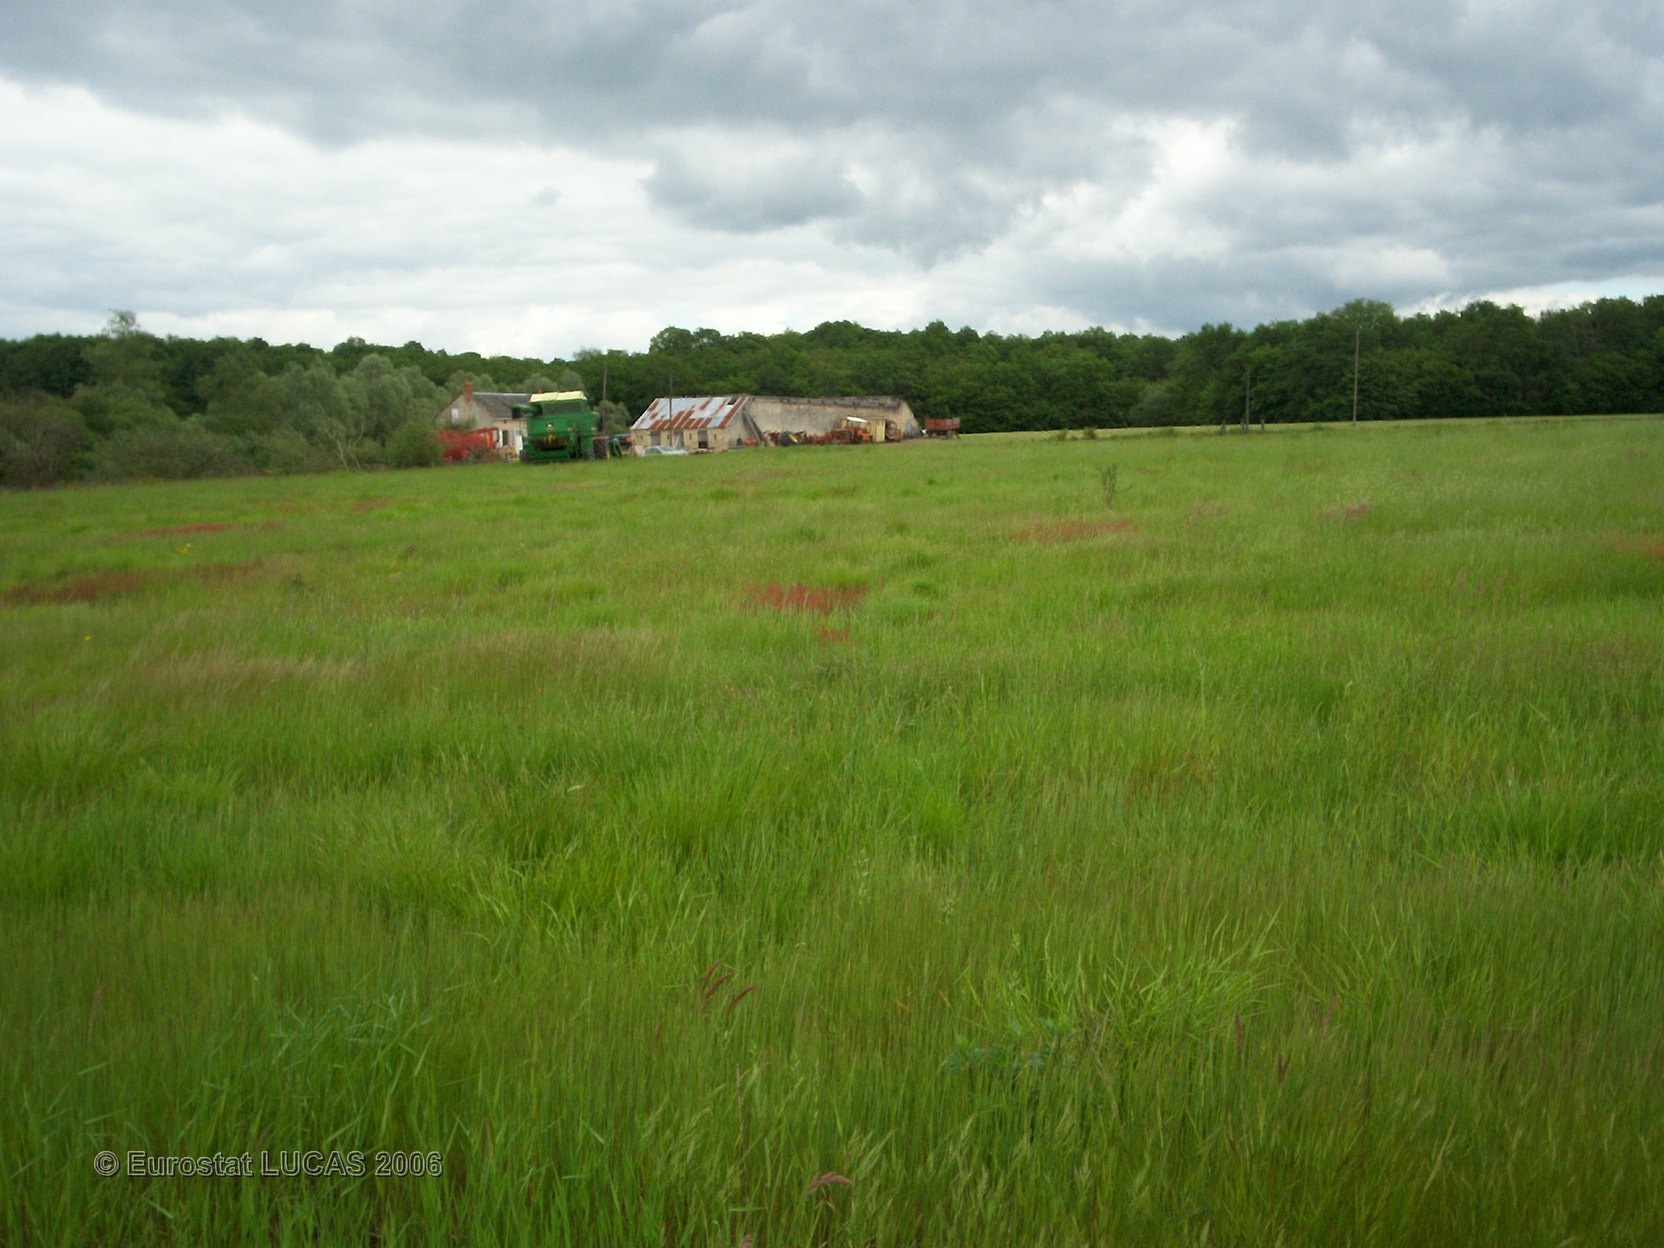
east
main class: Grassland
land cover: Grassland without tree/shrub cover
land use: Agriculture (excluding fallow land and kitchen gardens)
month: May
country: FR
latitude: 46.8597
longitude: 2.9521
